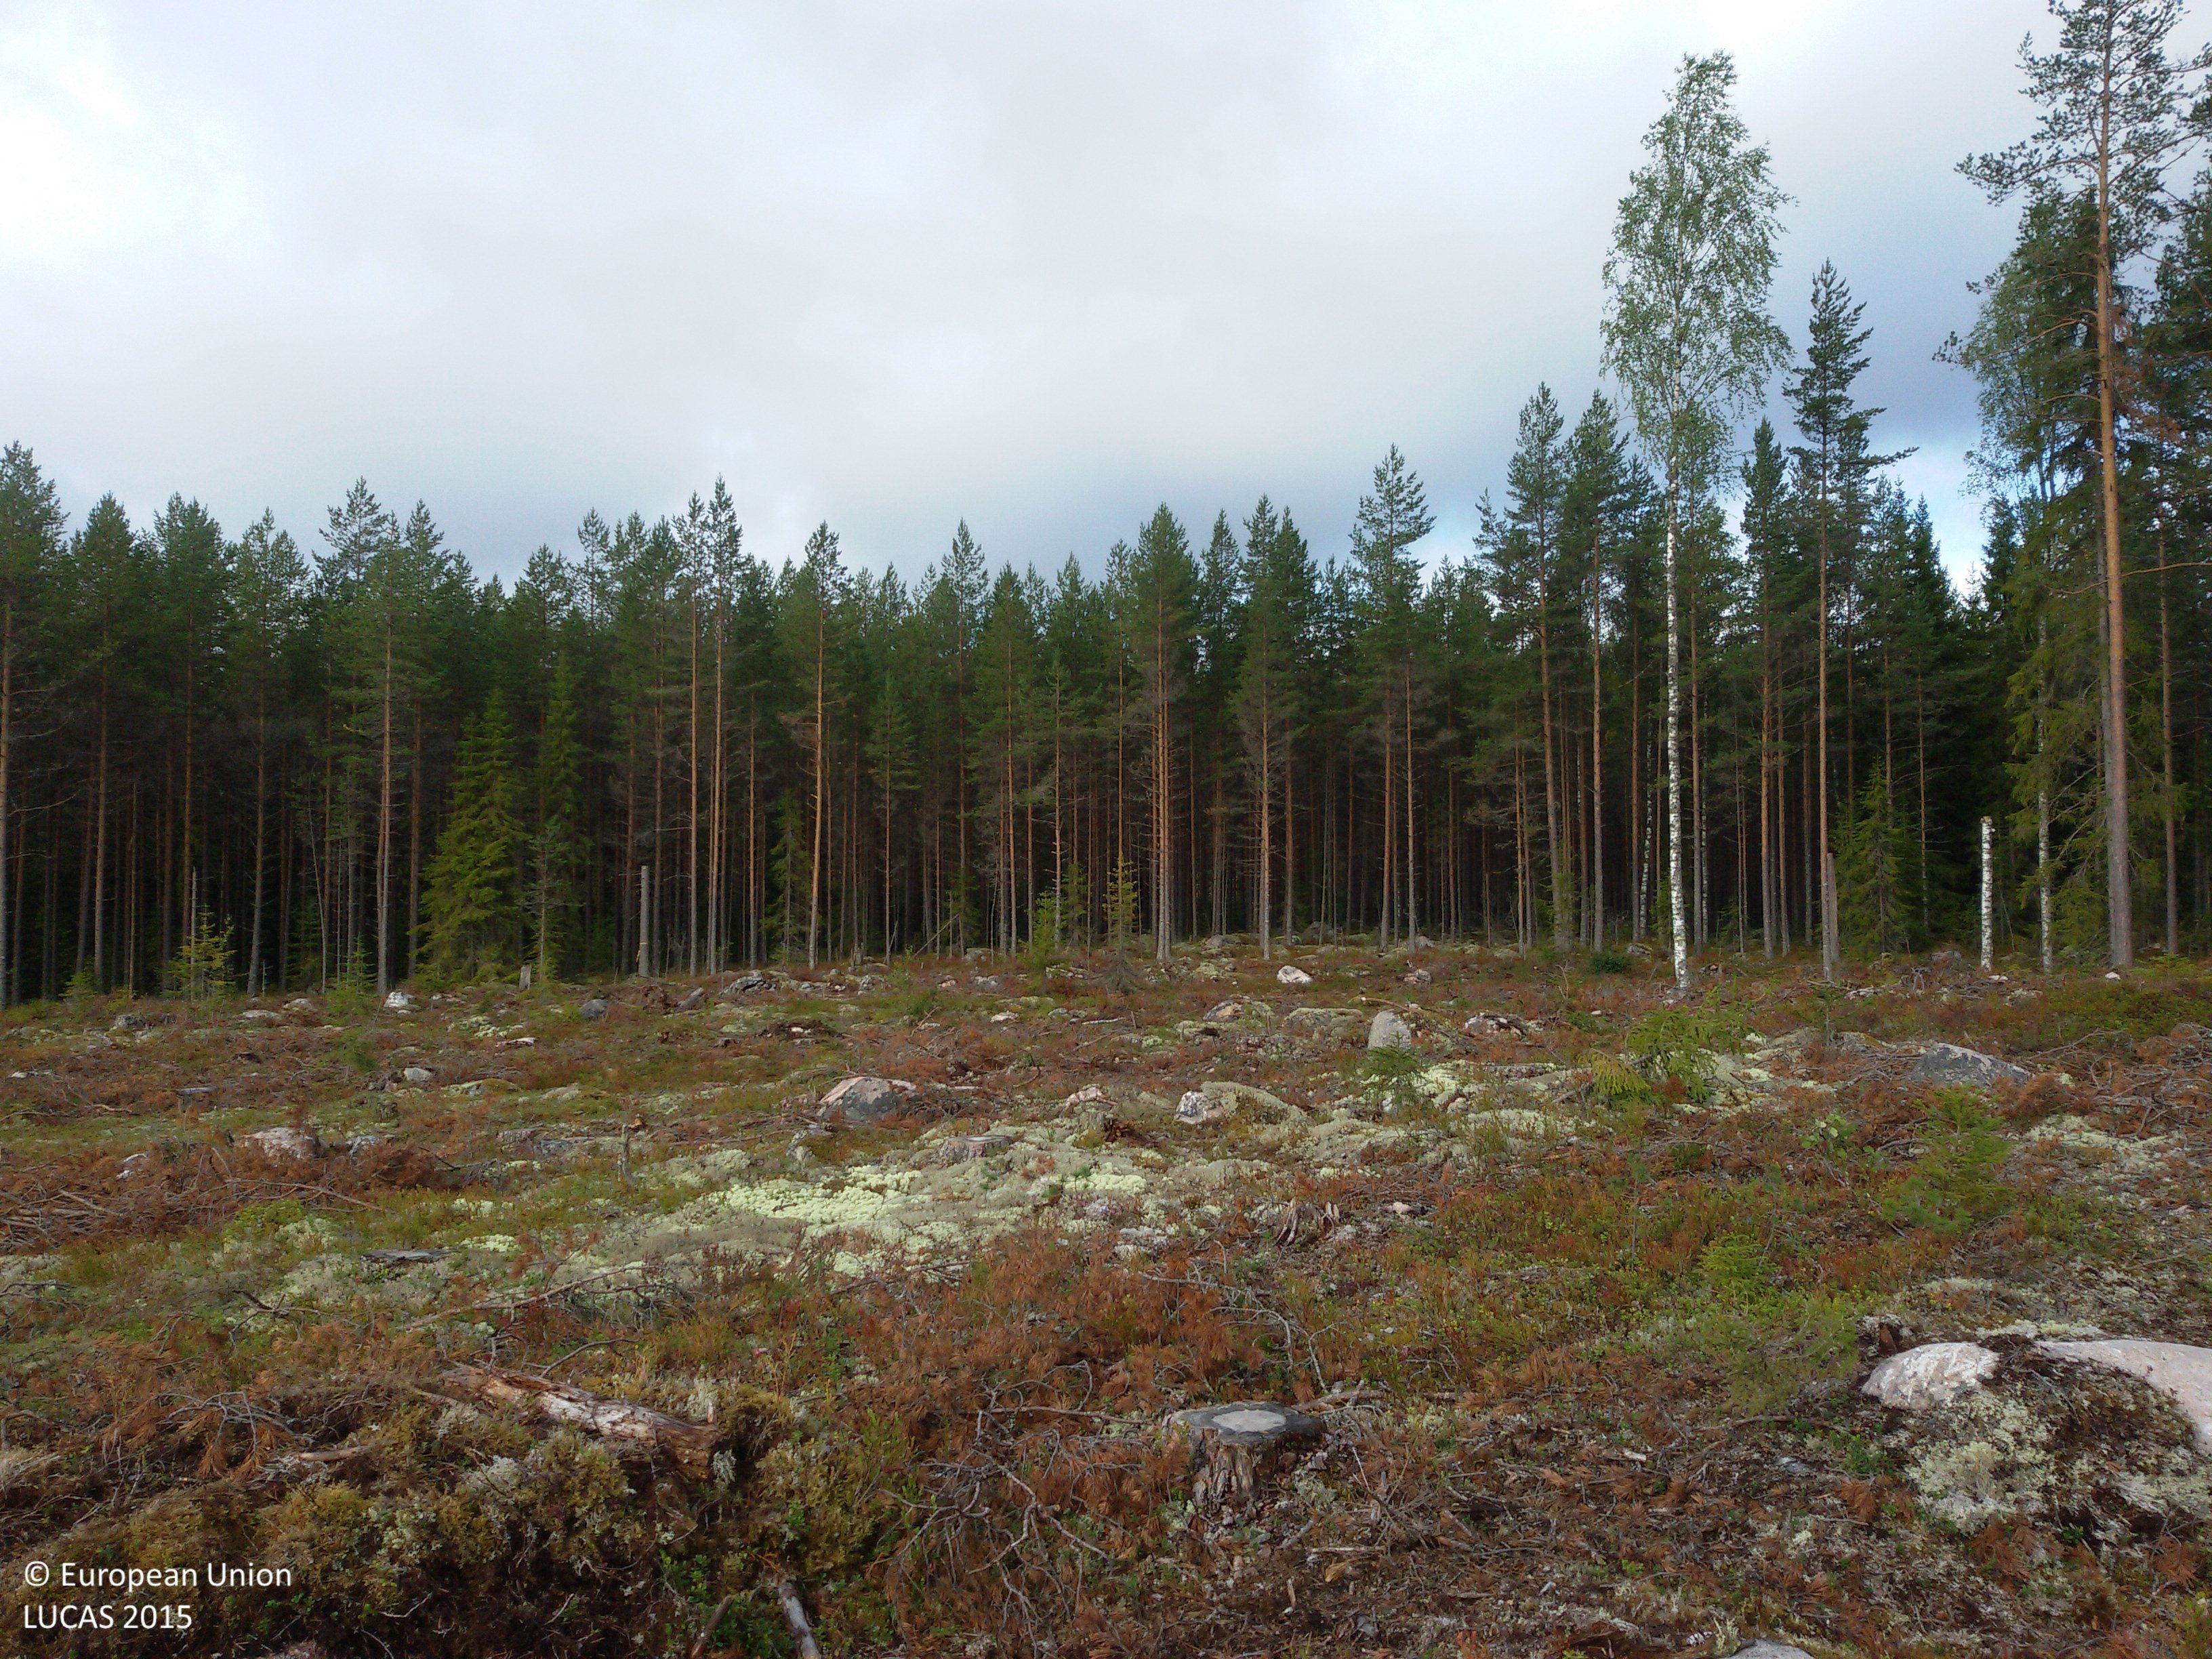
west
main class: Shrubland
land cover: Shrubland with sparse tree cover
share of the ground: 25 - 50 %
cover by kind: shrubs 35 %, lichens and mosses 25 %, unconsolidated bare surface 25 %, herbaceous plants 10 %, coniferous forest trees 5 %
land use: Forestry
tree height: < 5 m
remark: Clear cut
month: September
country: SE
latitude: 61.0351
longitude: 15.3726
